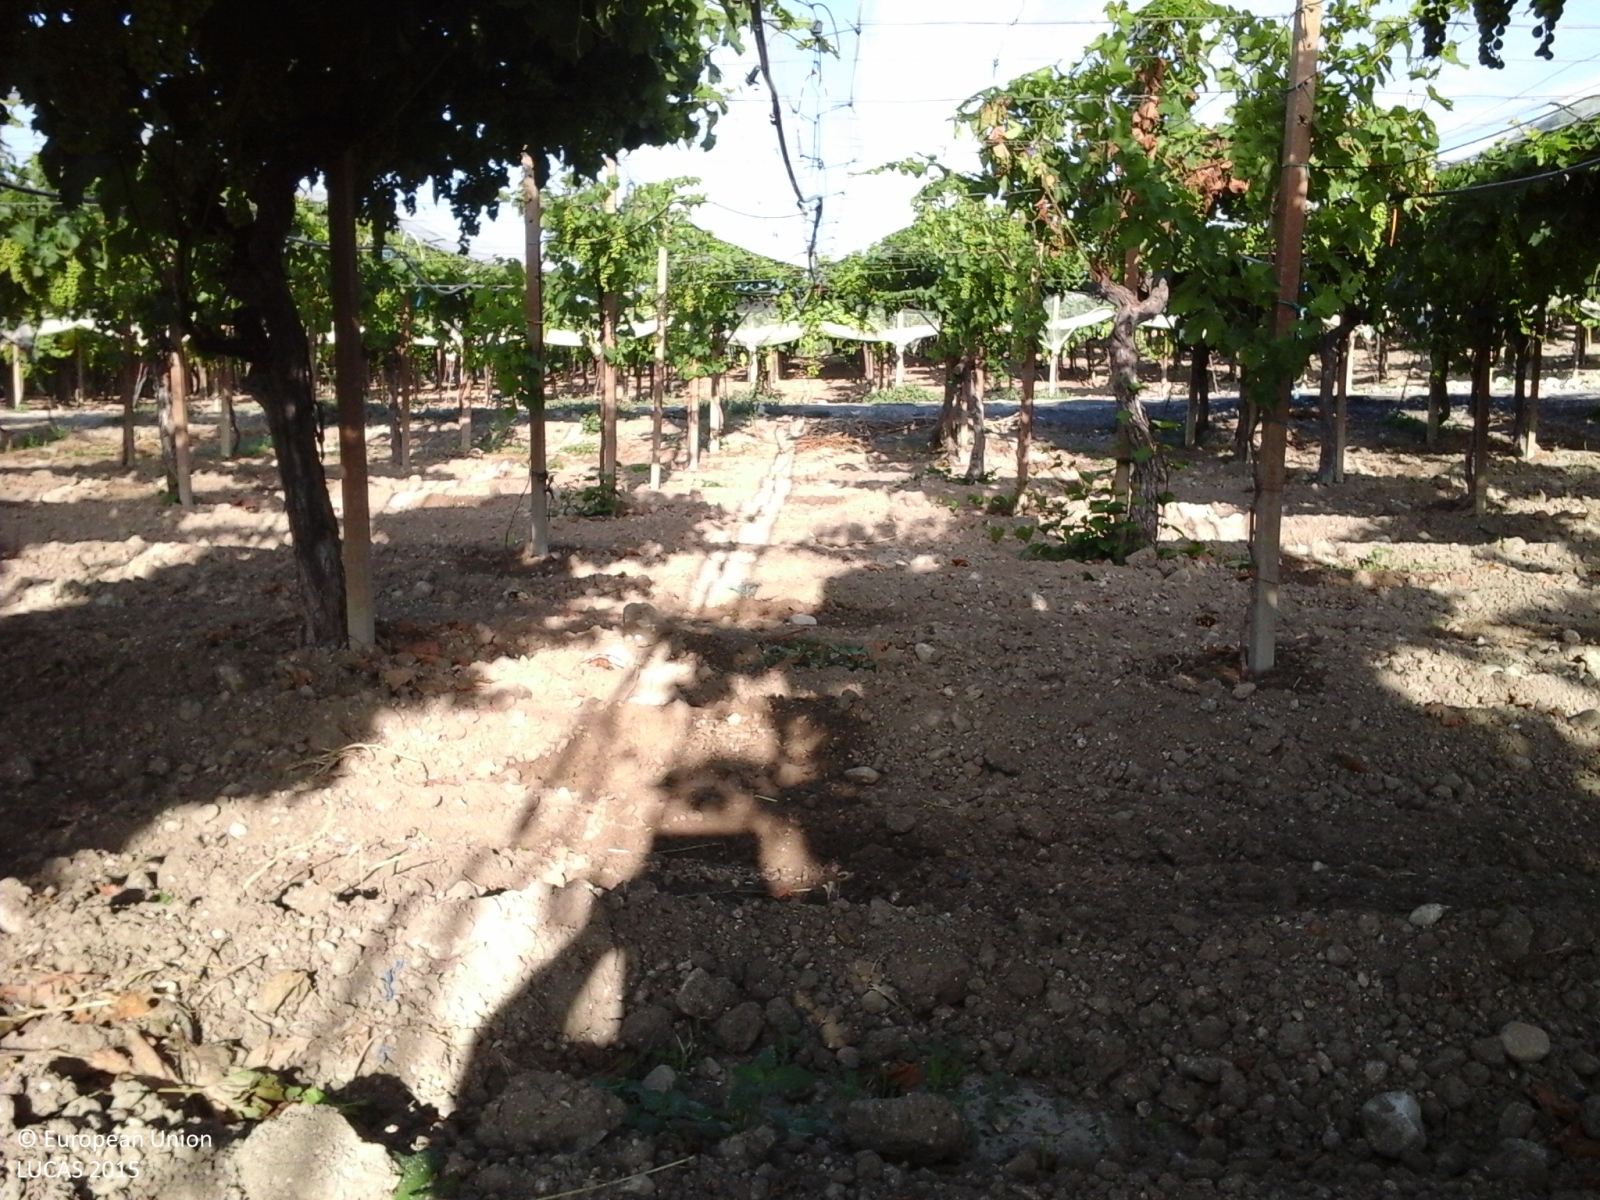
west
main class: Cropland
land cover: Vineyards
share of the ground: > 75 %
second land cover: Other bare soil
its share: > 75 %
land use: Agriculture (excluding fallow land and kitchen gardens)
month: June
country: IT
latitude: 37.1424
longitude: 14.6587
